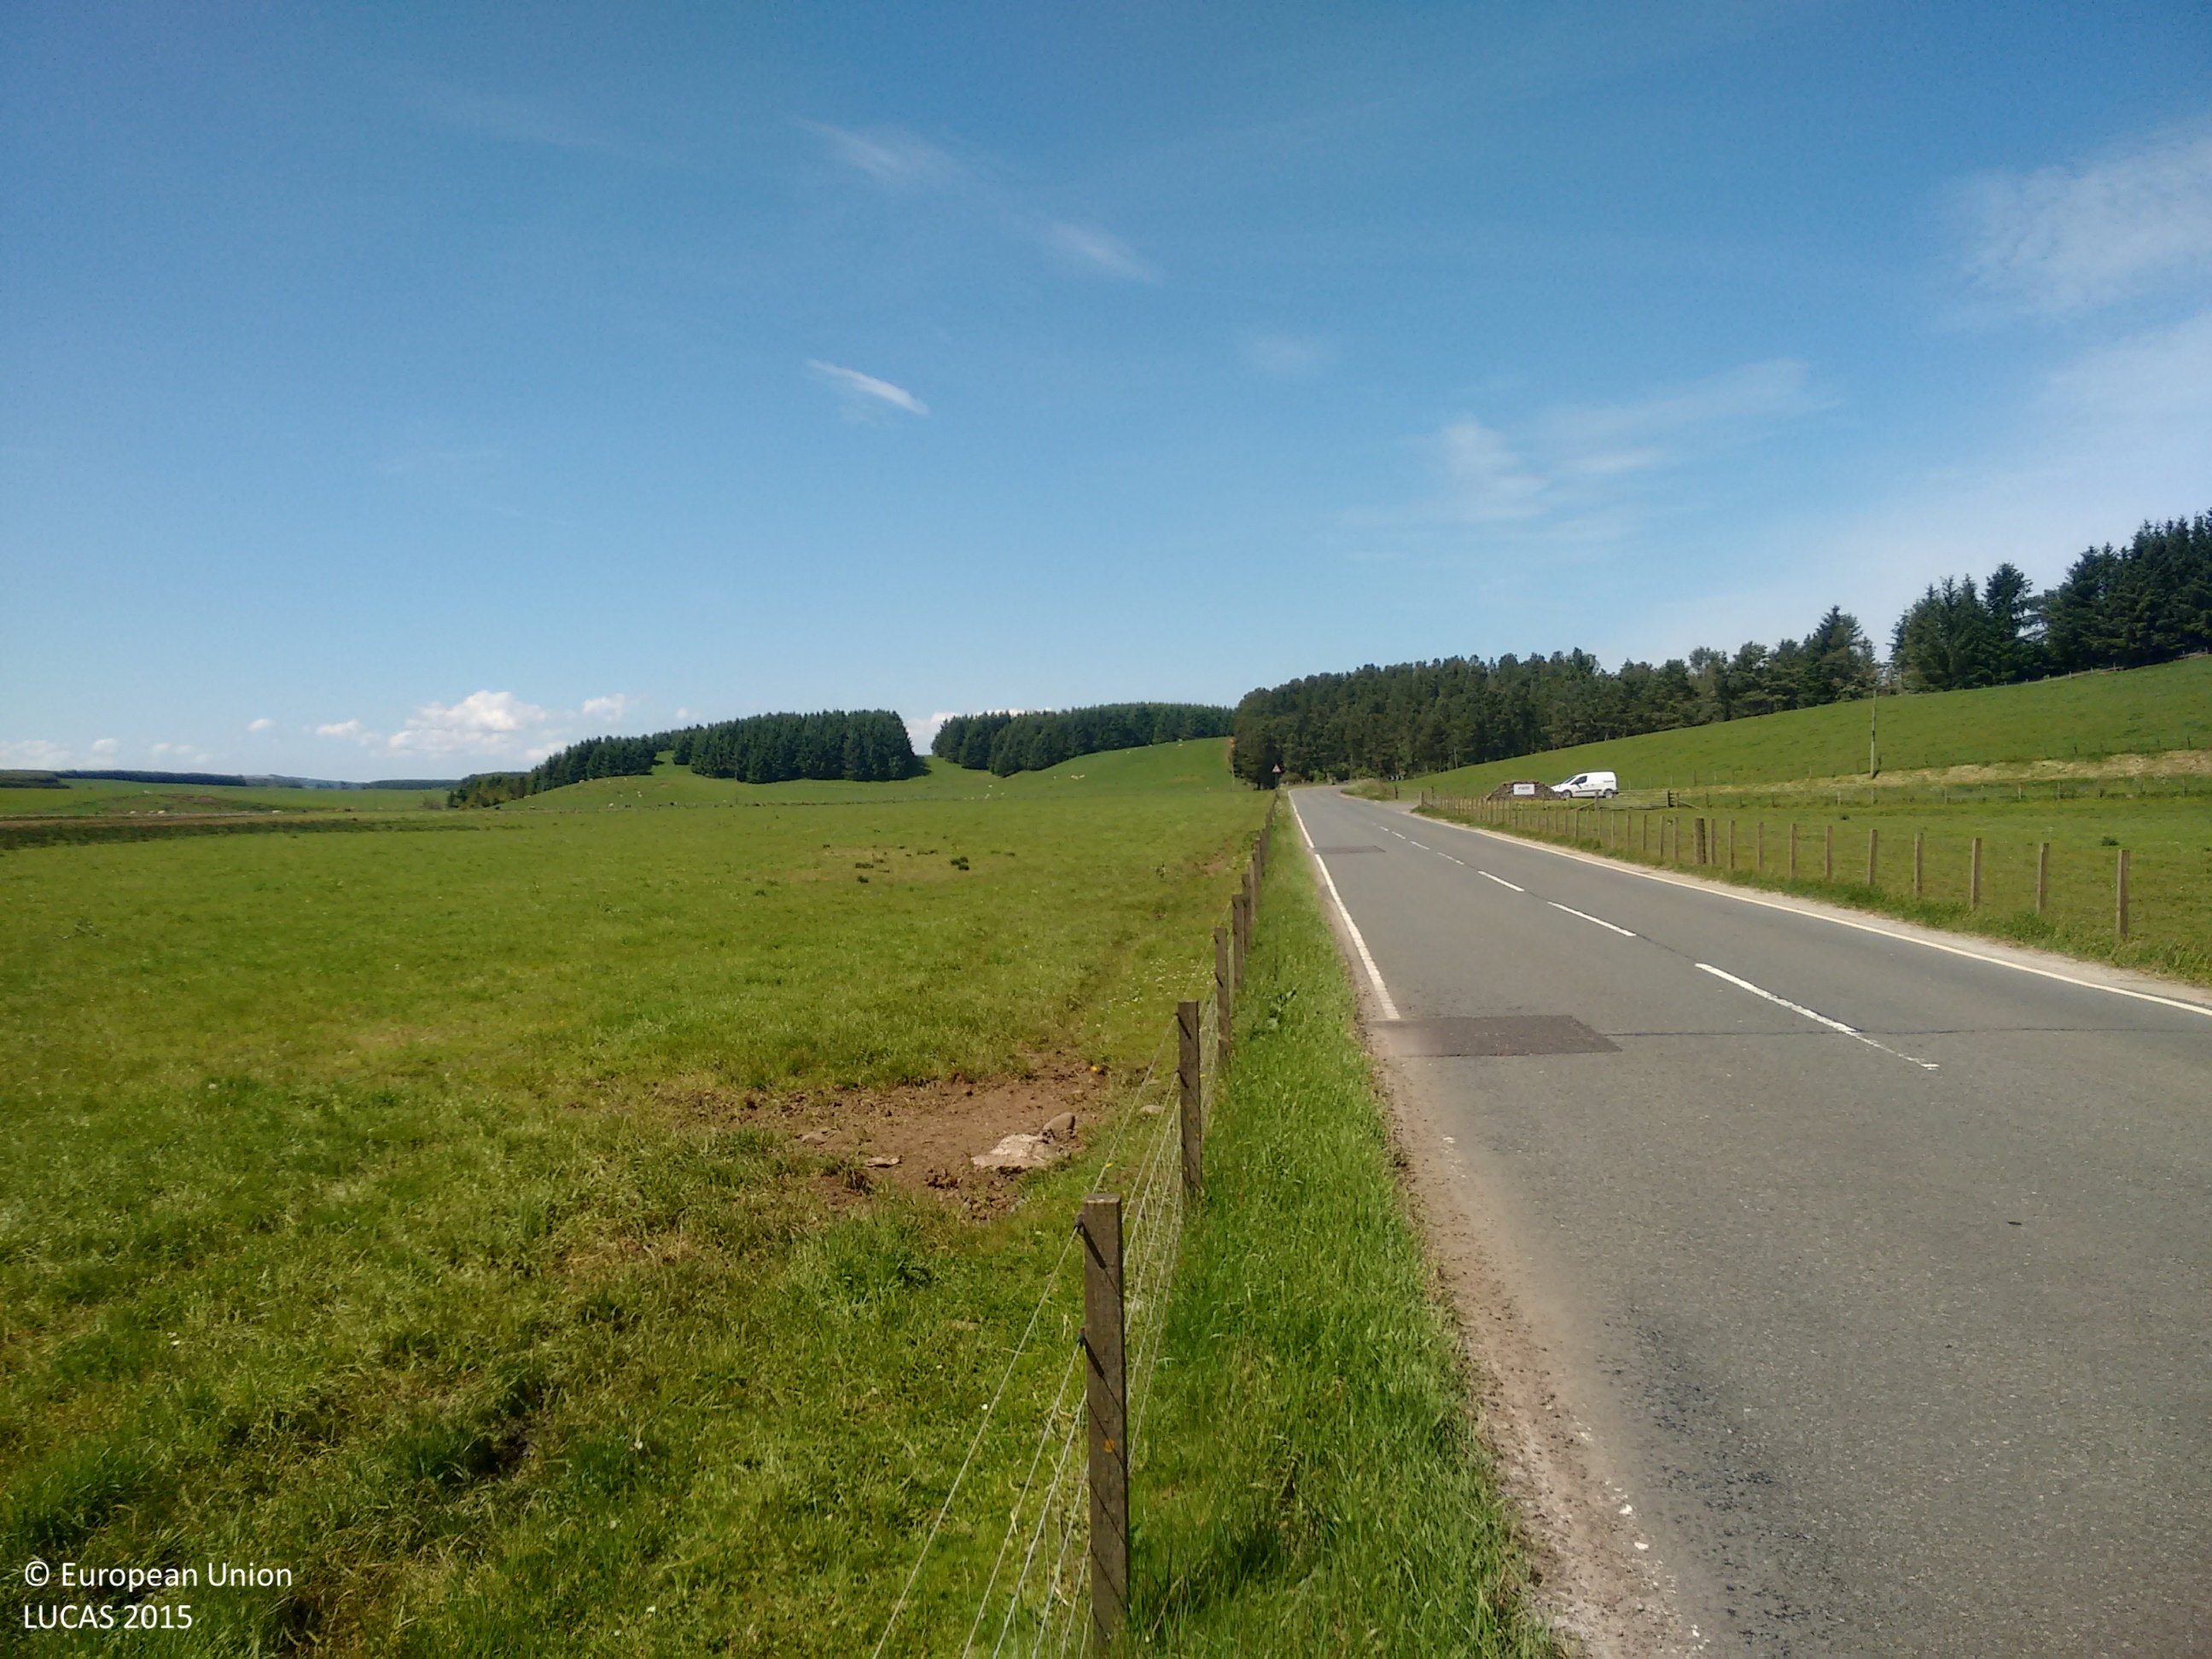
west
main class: Grassland
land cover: Grassland without tree/shrub cover
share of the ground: > 75 %
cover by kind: herbaceous plants 75 %, lichens and mosses 25 %
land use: Agriculture (excluding fallow land and kitchen gardens)
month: June
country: GB
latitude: 55.6836
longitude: -3.5508
